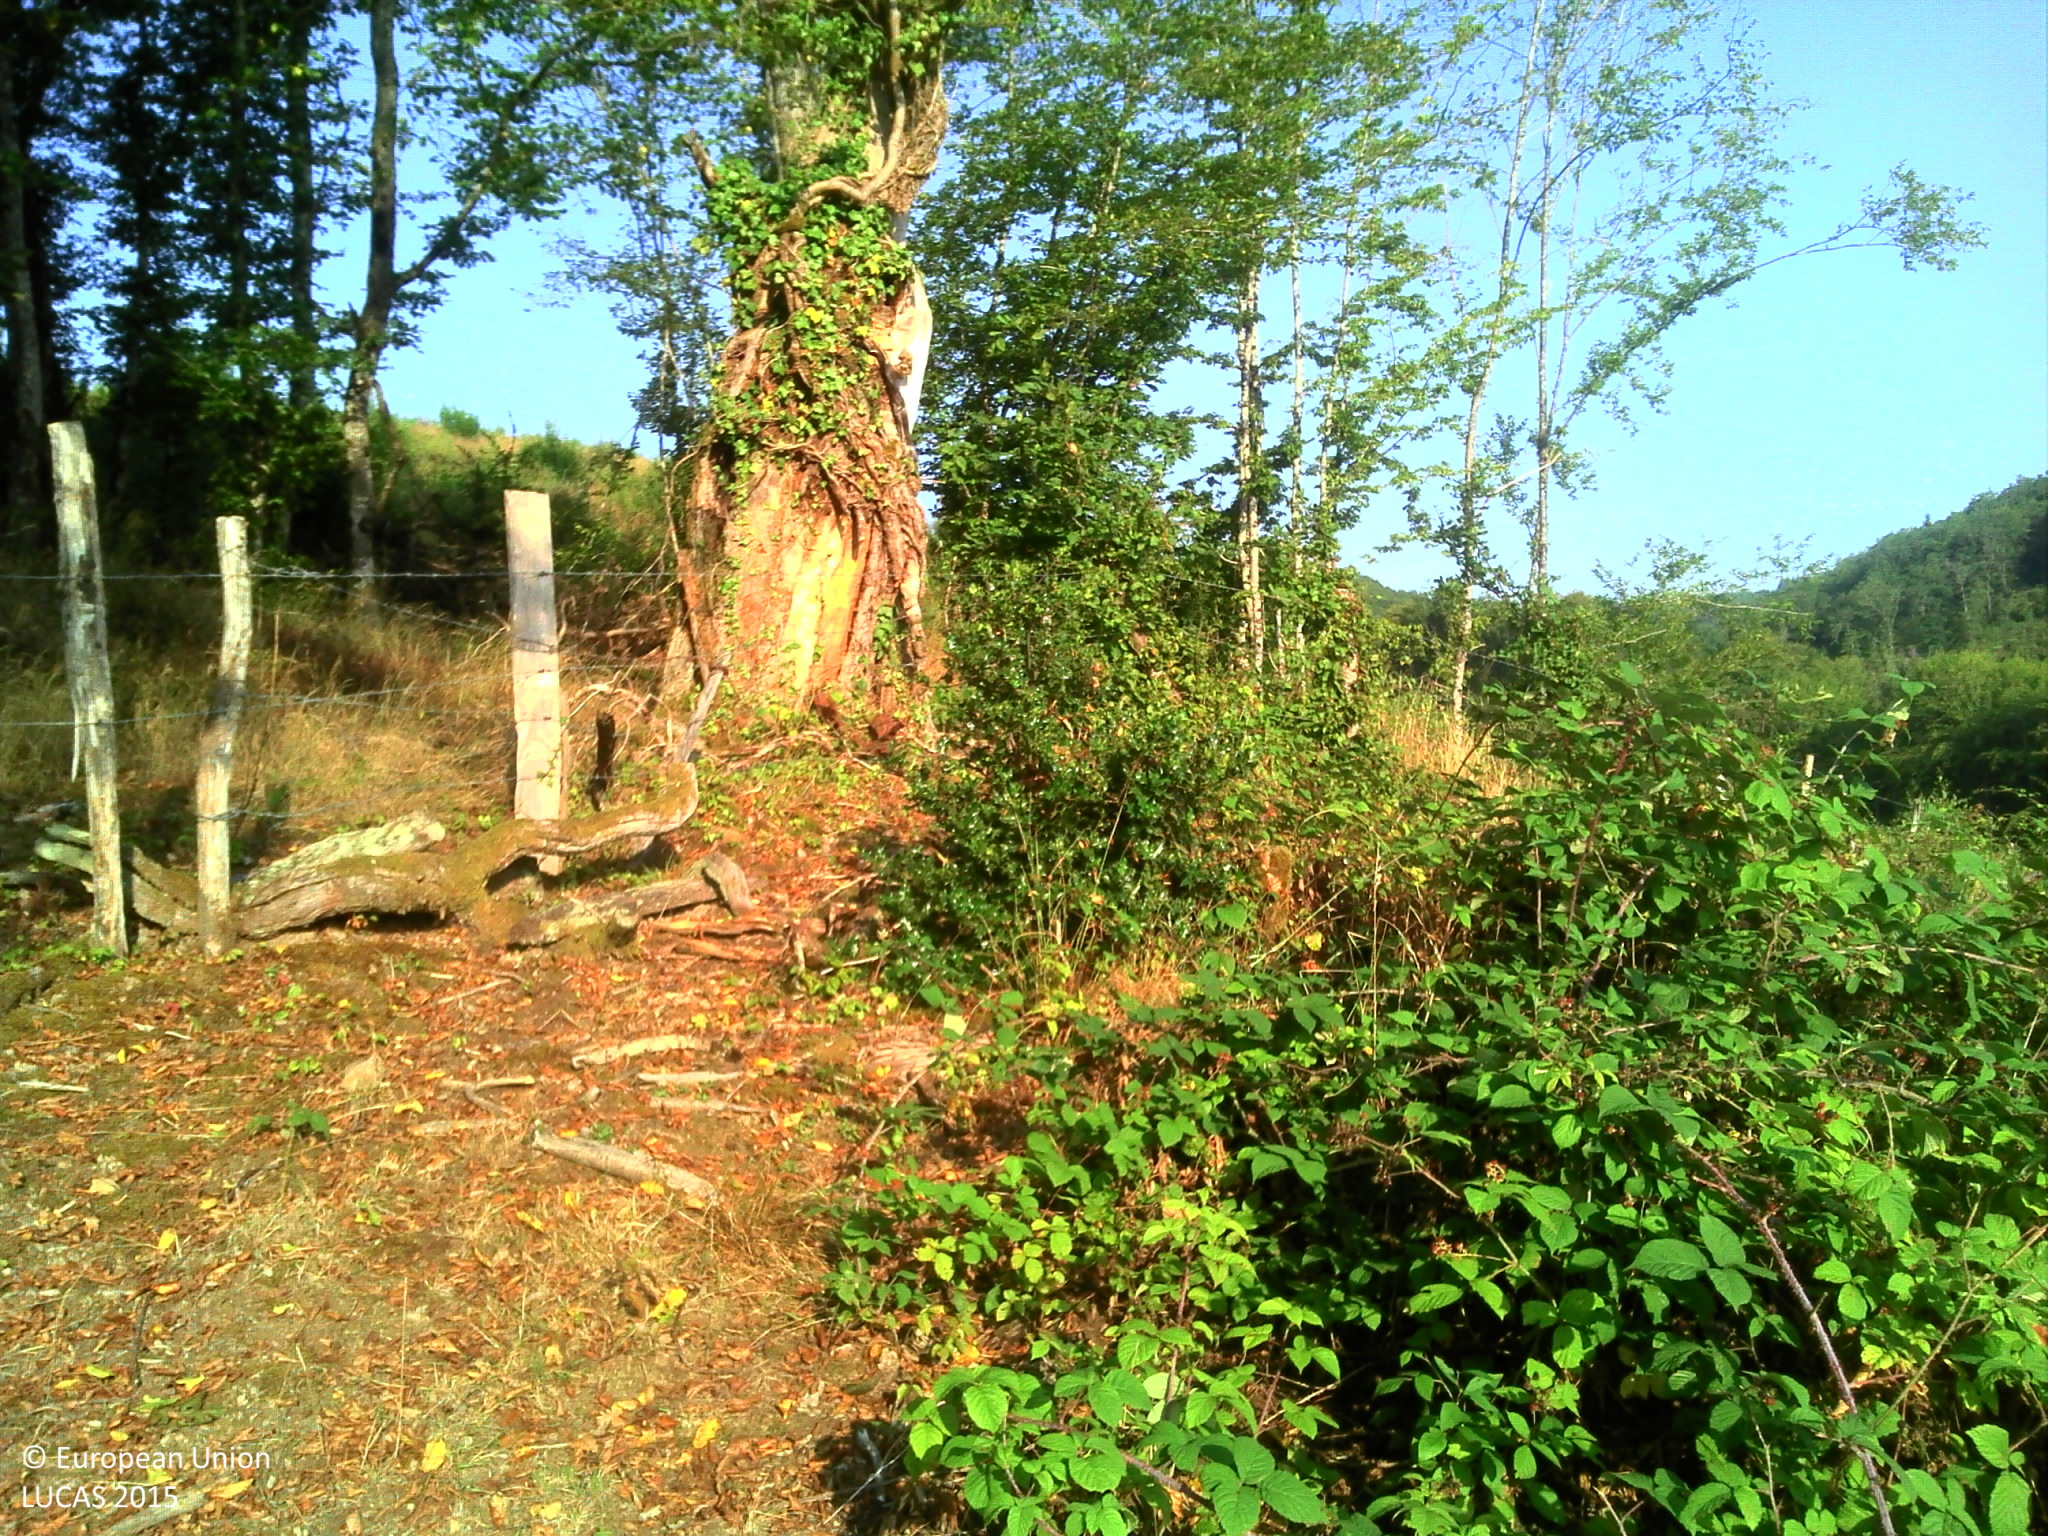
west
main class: Shrubland
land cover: Shrubland without tree cover
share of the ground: > 75 %
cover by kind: shrubs 50 %, herbaceous plants 50 %
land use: Forestry
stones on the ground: < 10 %
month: August
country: FR
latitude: 47.1028
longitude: 4.3205
